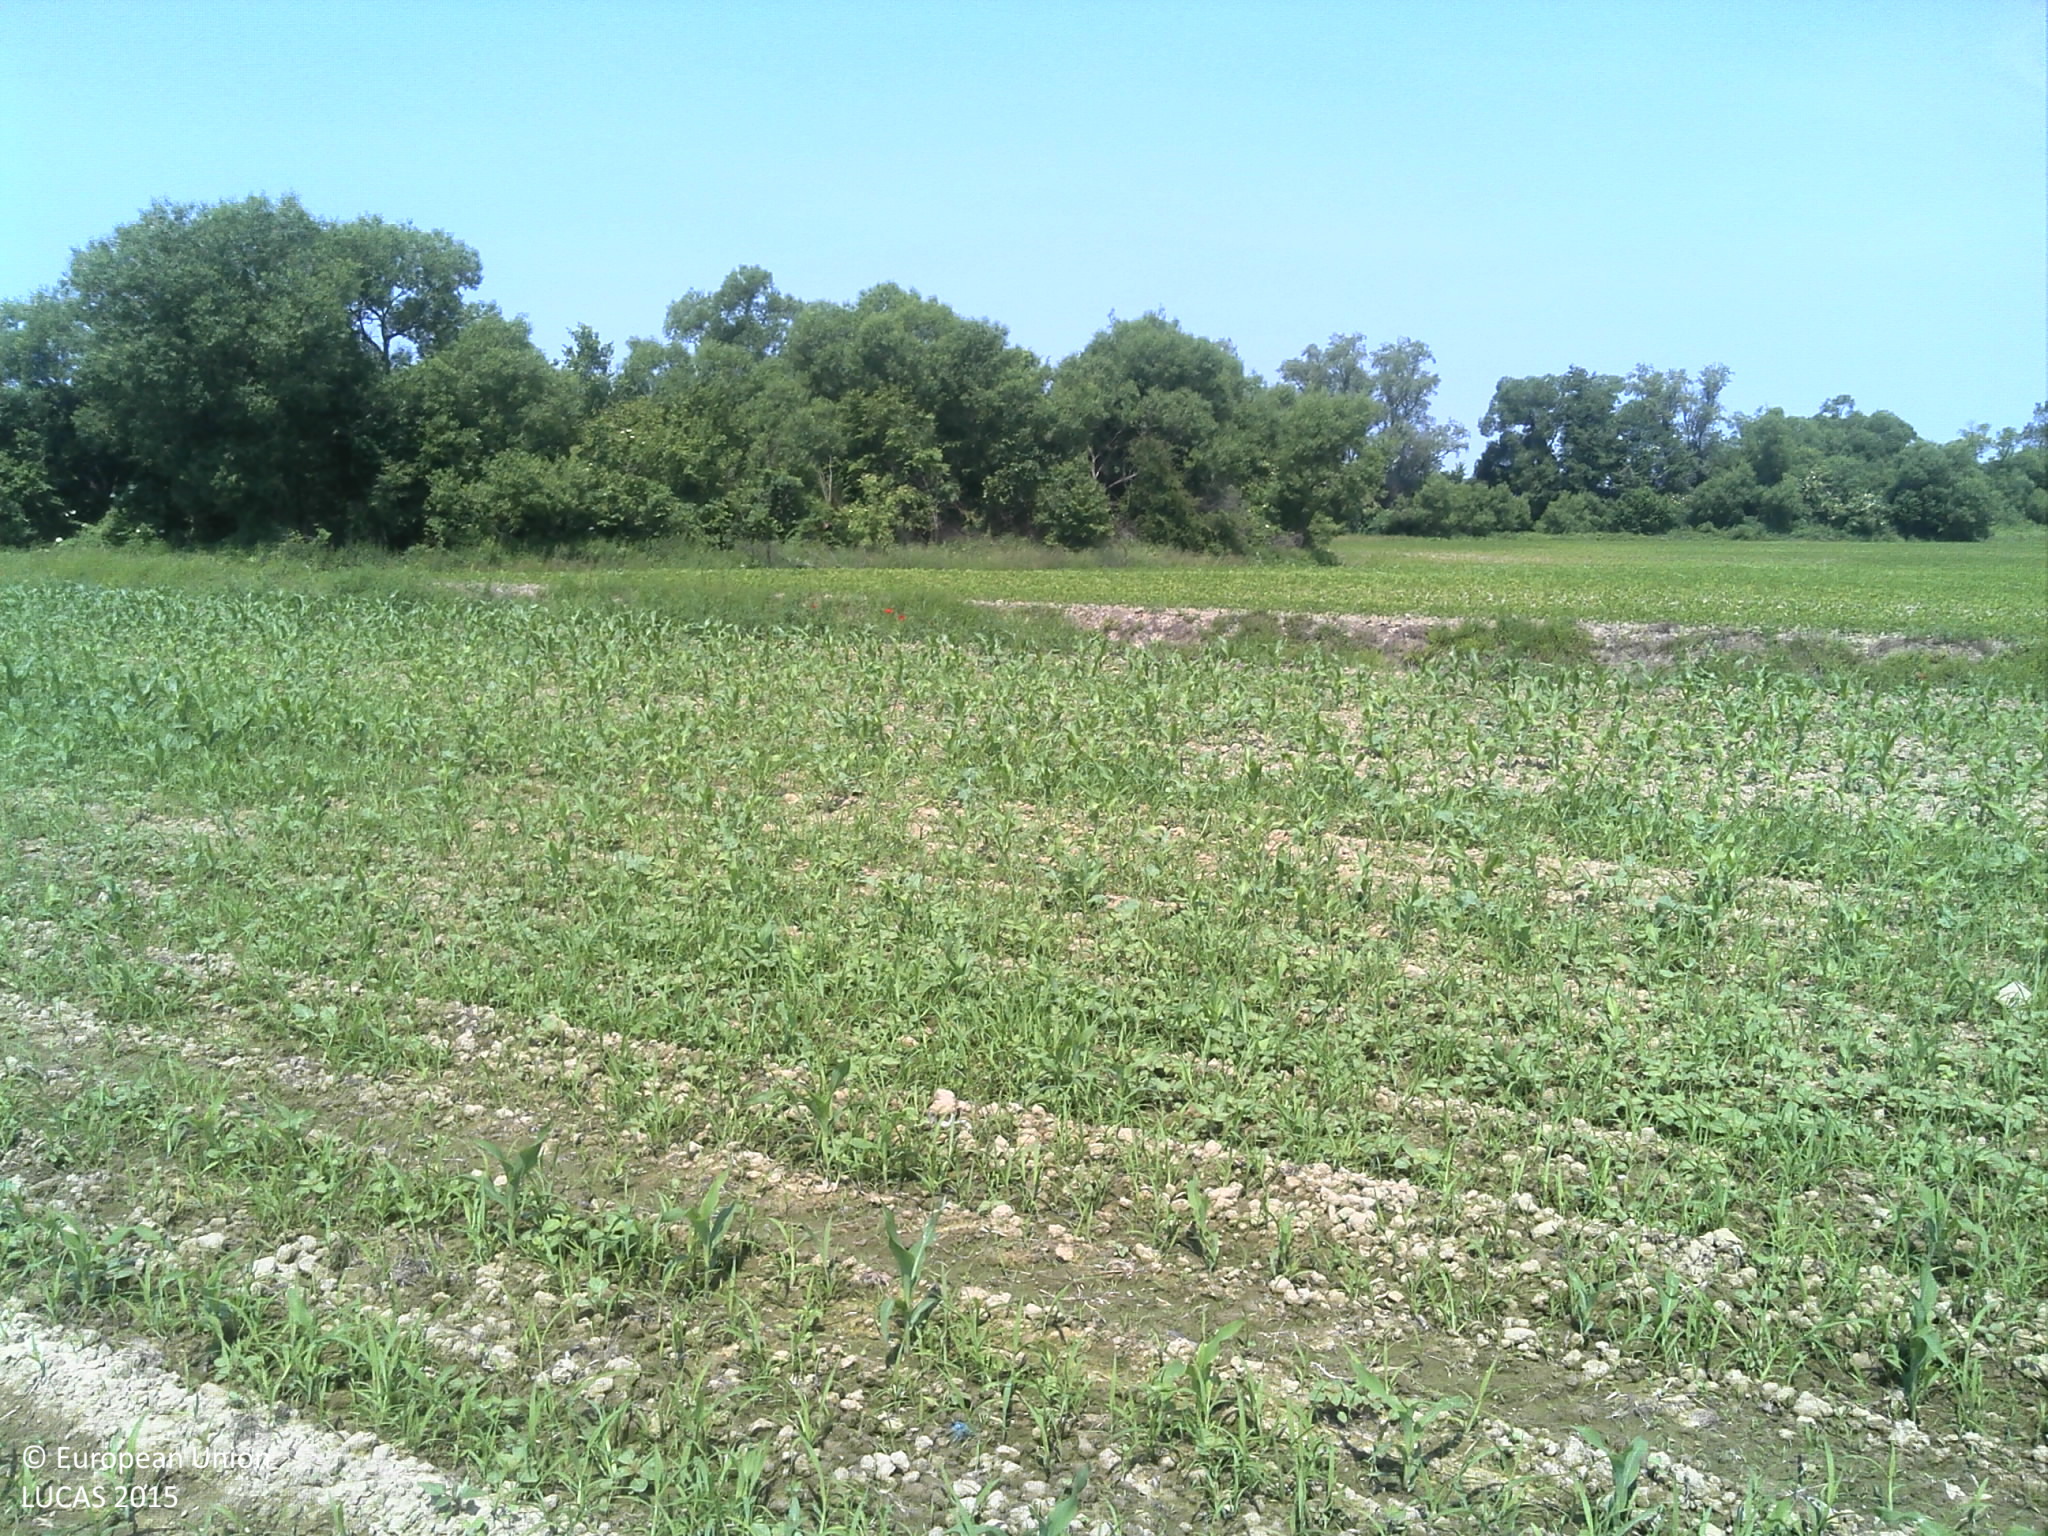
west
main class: Cropland
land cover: Maize
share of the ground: 25 - 50 %
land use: Agriculture (excluding fallow land and kitchen gardens)
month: June
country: HR
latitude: 45.6749
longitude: 17.9506
